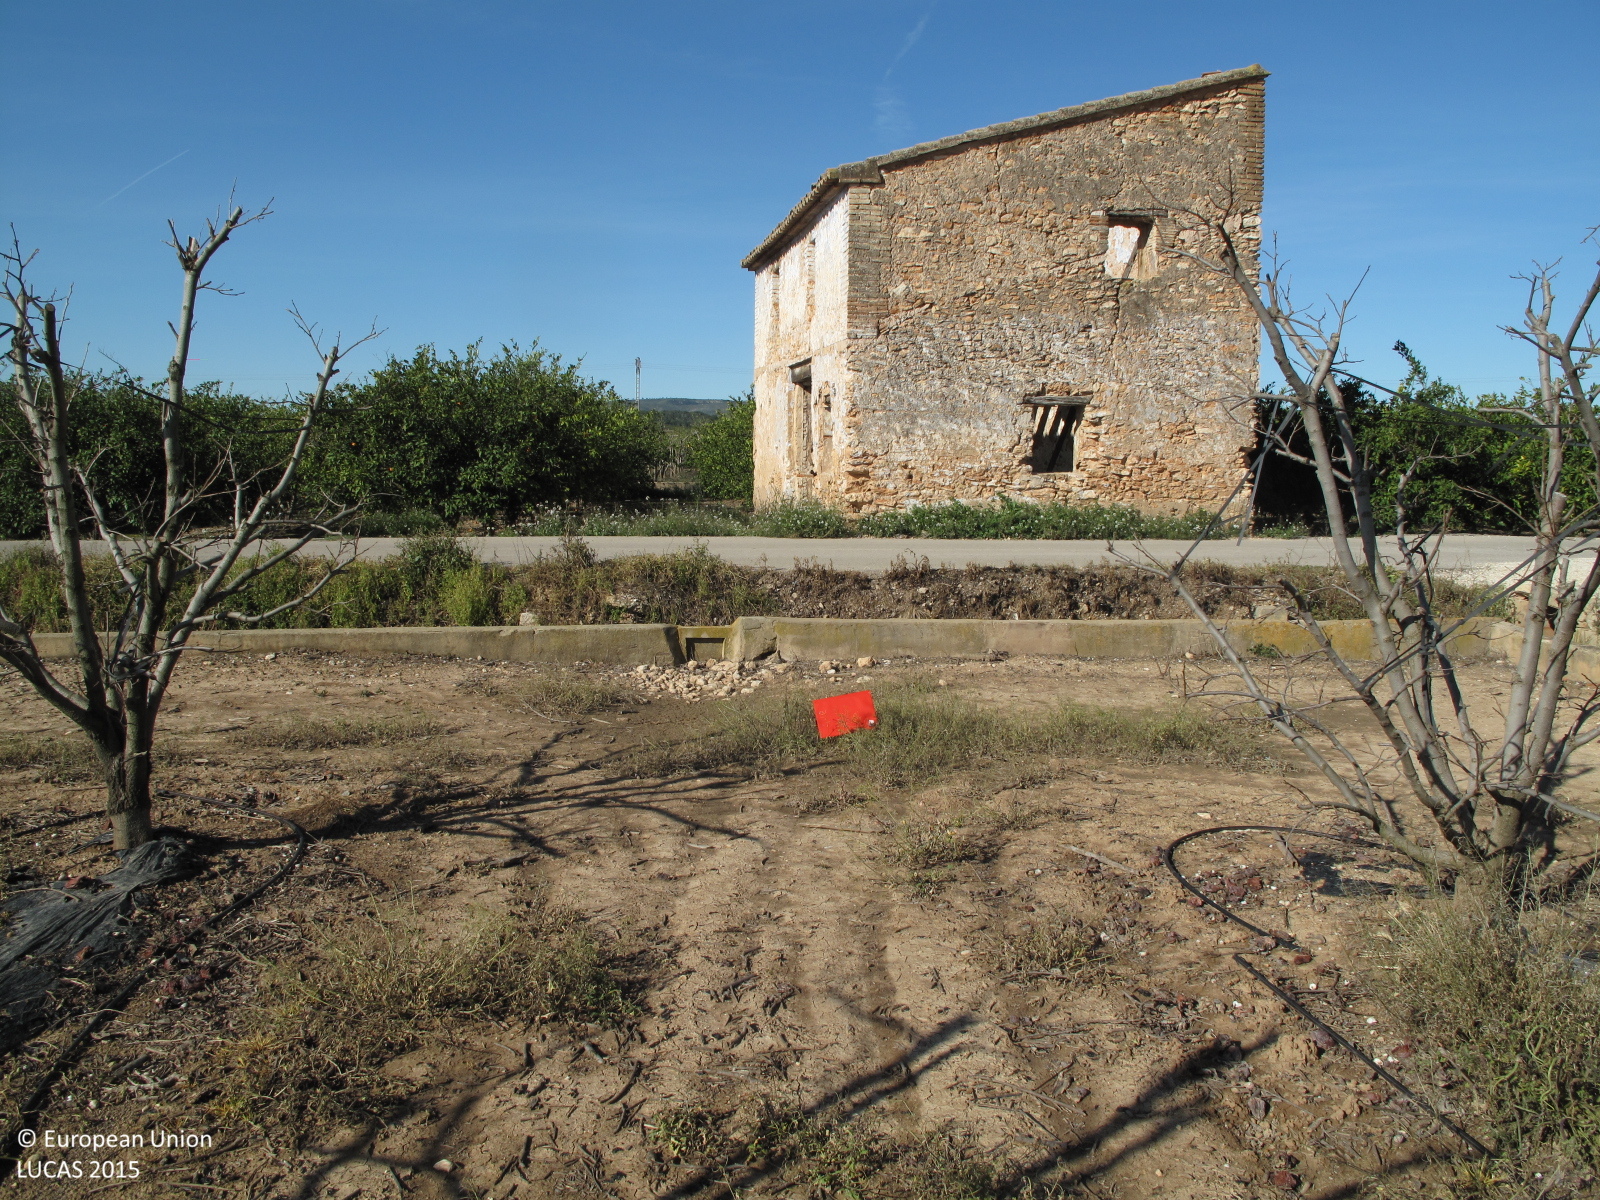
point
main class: Cropland
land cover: Other fruit trees and berries
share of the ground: 25 - 50 %
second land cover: Spontaneously vegetated surfaces
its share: 10 - 25 %
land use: Agriculture (excluding fallow land and kitchen gardens)
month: March
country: ES
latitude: 39.1512
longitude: -0.5361
